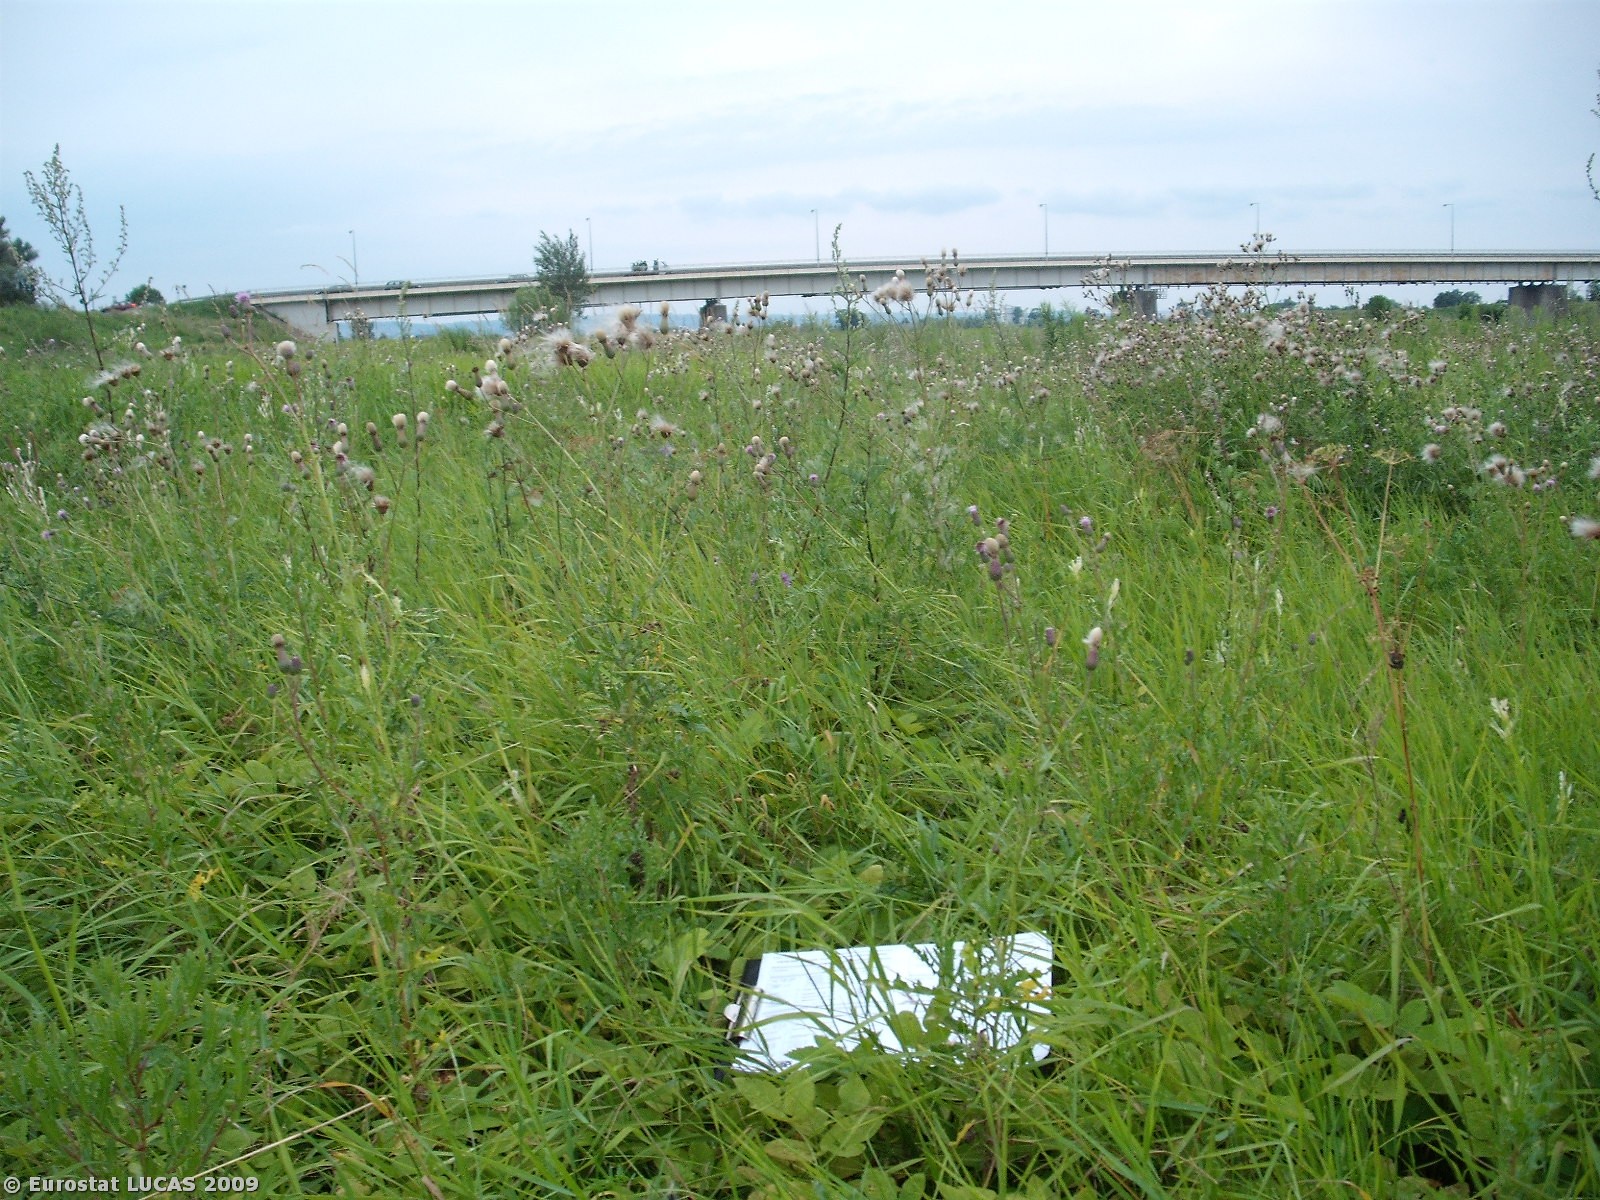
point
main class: Grassland
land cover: Grassland without tree/shrub cover
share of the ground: > 75 %
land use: Unused
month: July
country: PL
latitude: 50.0505
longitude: 20.2155
